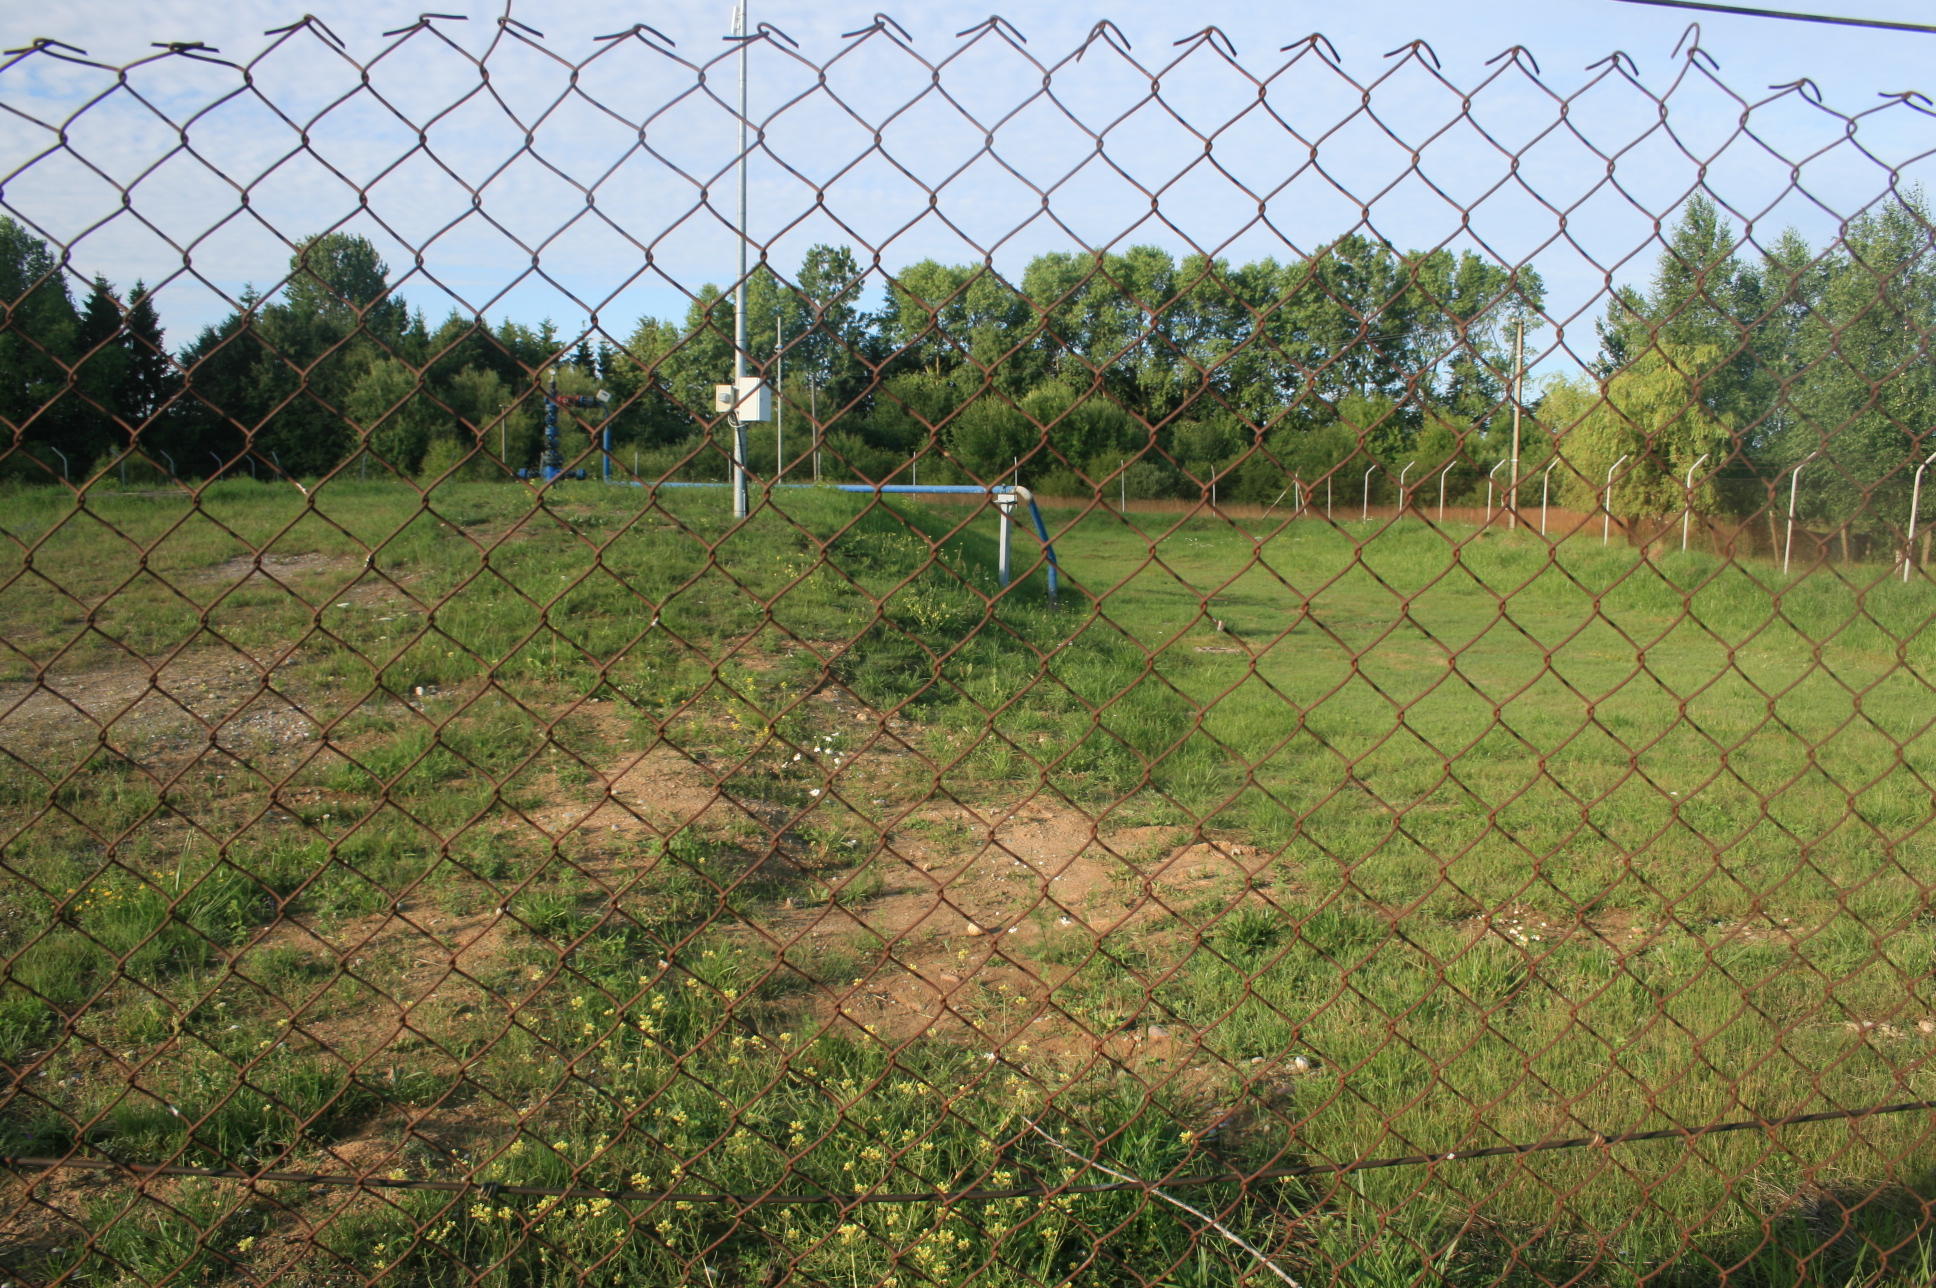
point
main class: Grassland
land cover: Grassland without tree/shrub cover
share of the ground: > 75 %
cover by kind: herbaceous plants 80 %, unconsolidated bare surface 20 %
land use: Transport via pipelines
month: July
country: LT
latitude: 55.8763
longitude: 21.2133
